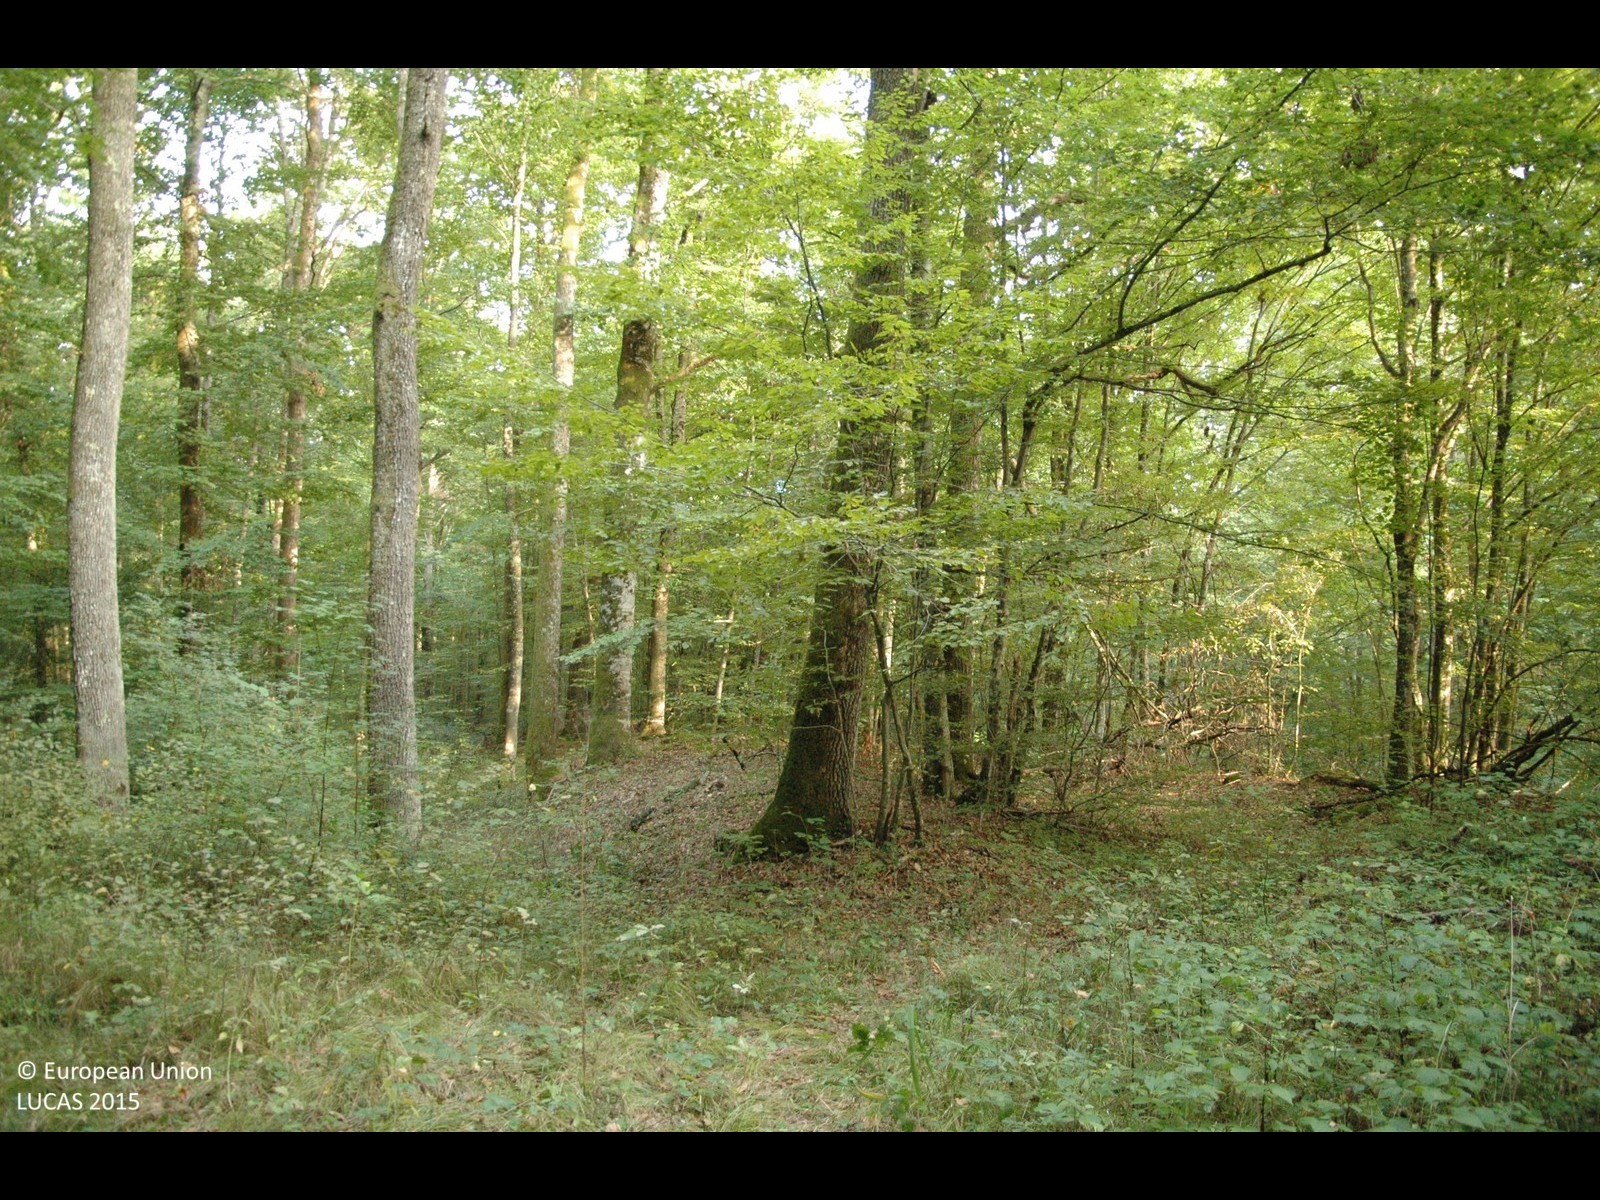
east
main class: Woodland
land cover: Broadleaved woodland
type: mesophytic deciduous forest
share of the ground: > 75 %
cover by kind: broadleaved forest trees 100 %
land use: Forestry
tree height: > 5 m
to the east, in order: Broadleaved woodland
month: October
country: HR
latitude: 45.5385
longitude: 16.2087
